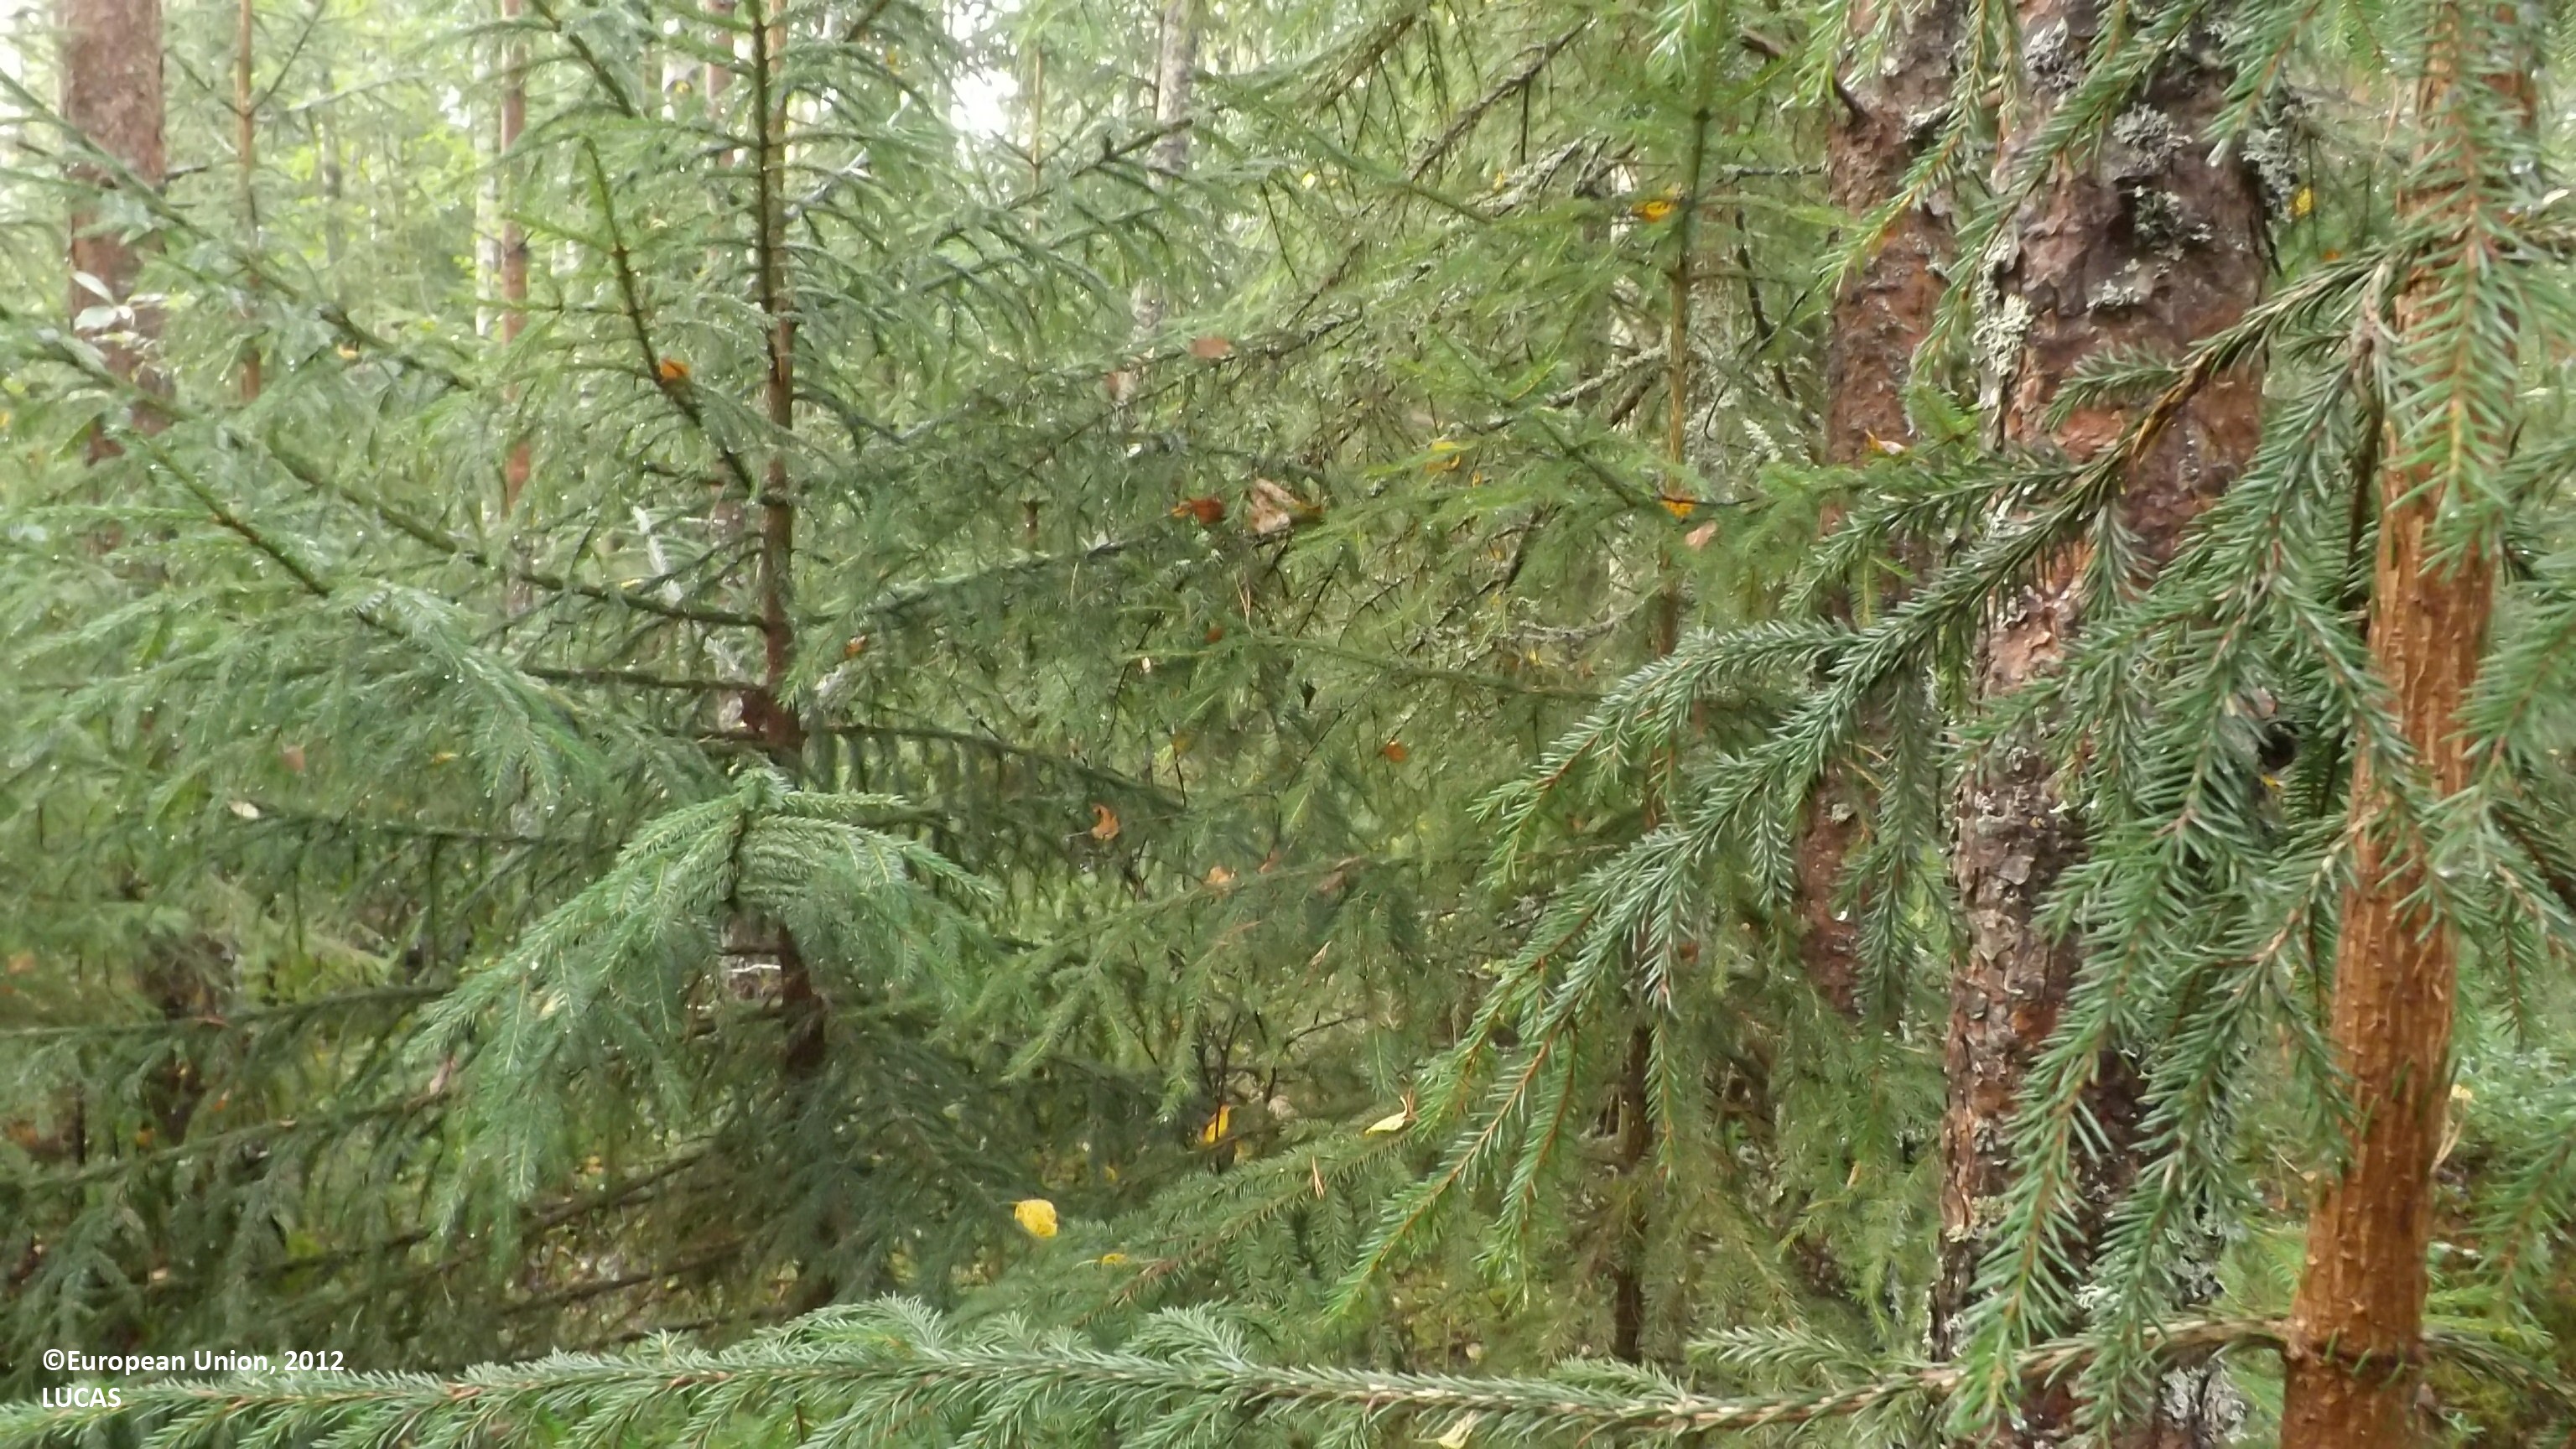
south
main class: Woodland
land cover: Other mixed woodland
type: boreal forest
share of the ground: > 75 %
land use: Forestry
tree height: > 5 m
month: August
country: FI
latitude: 63.8932
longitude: 23.4804
